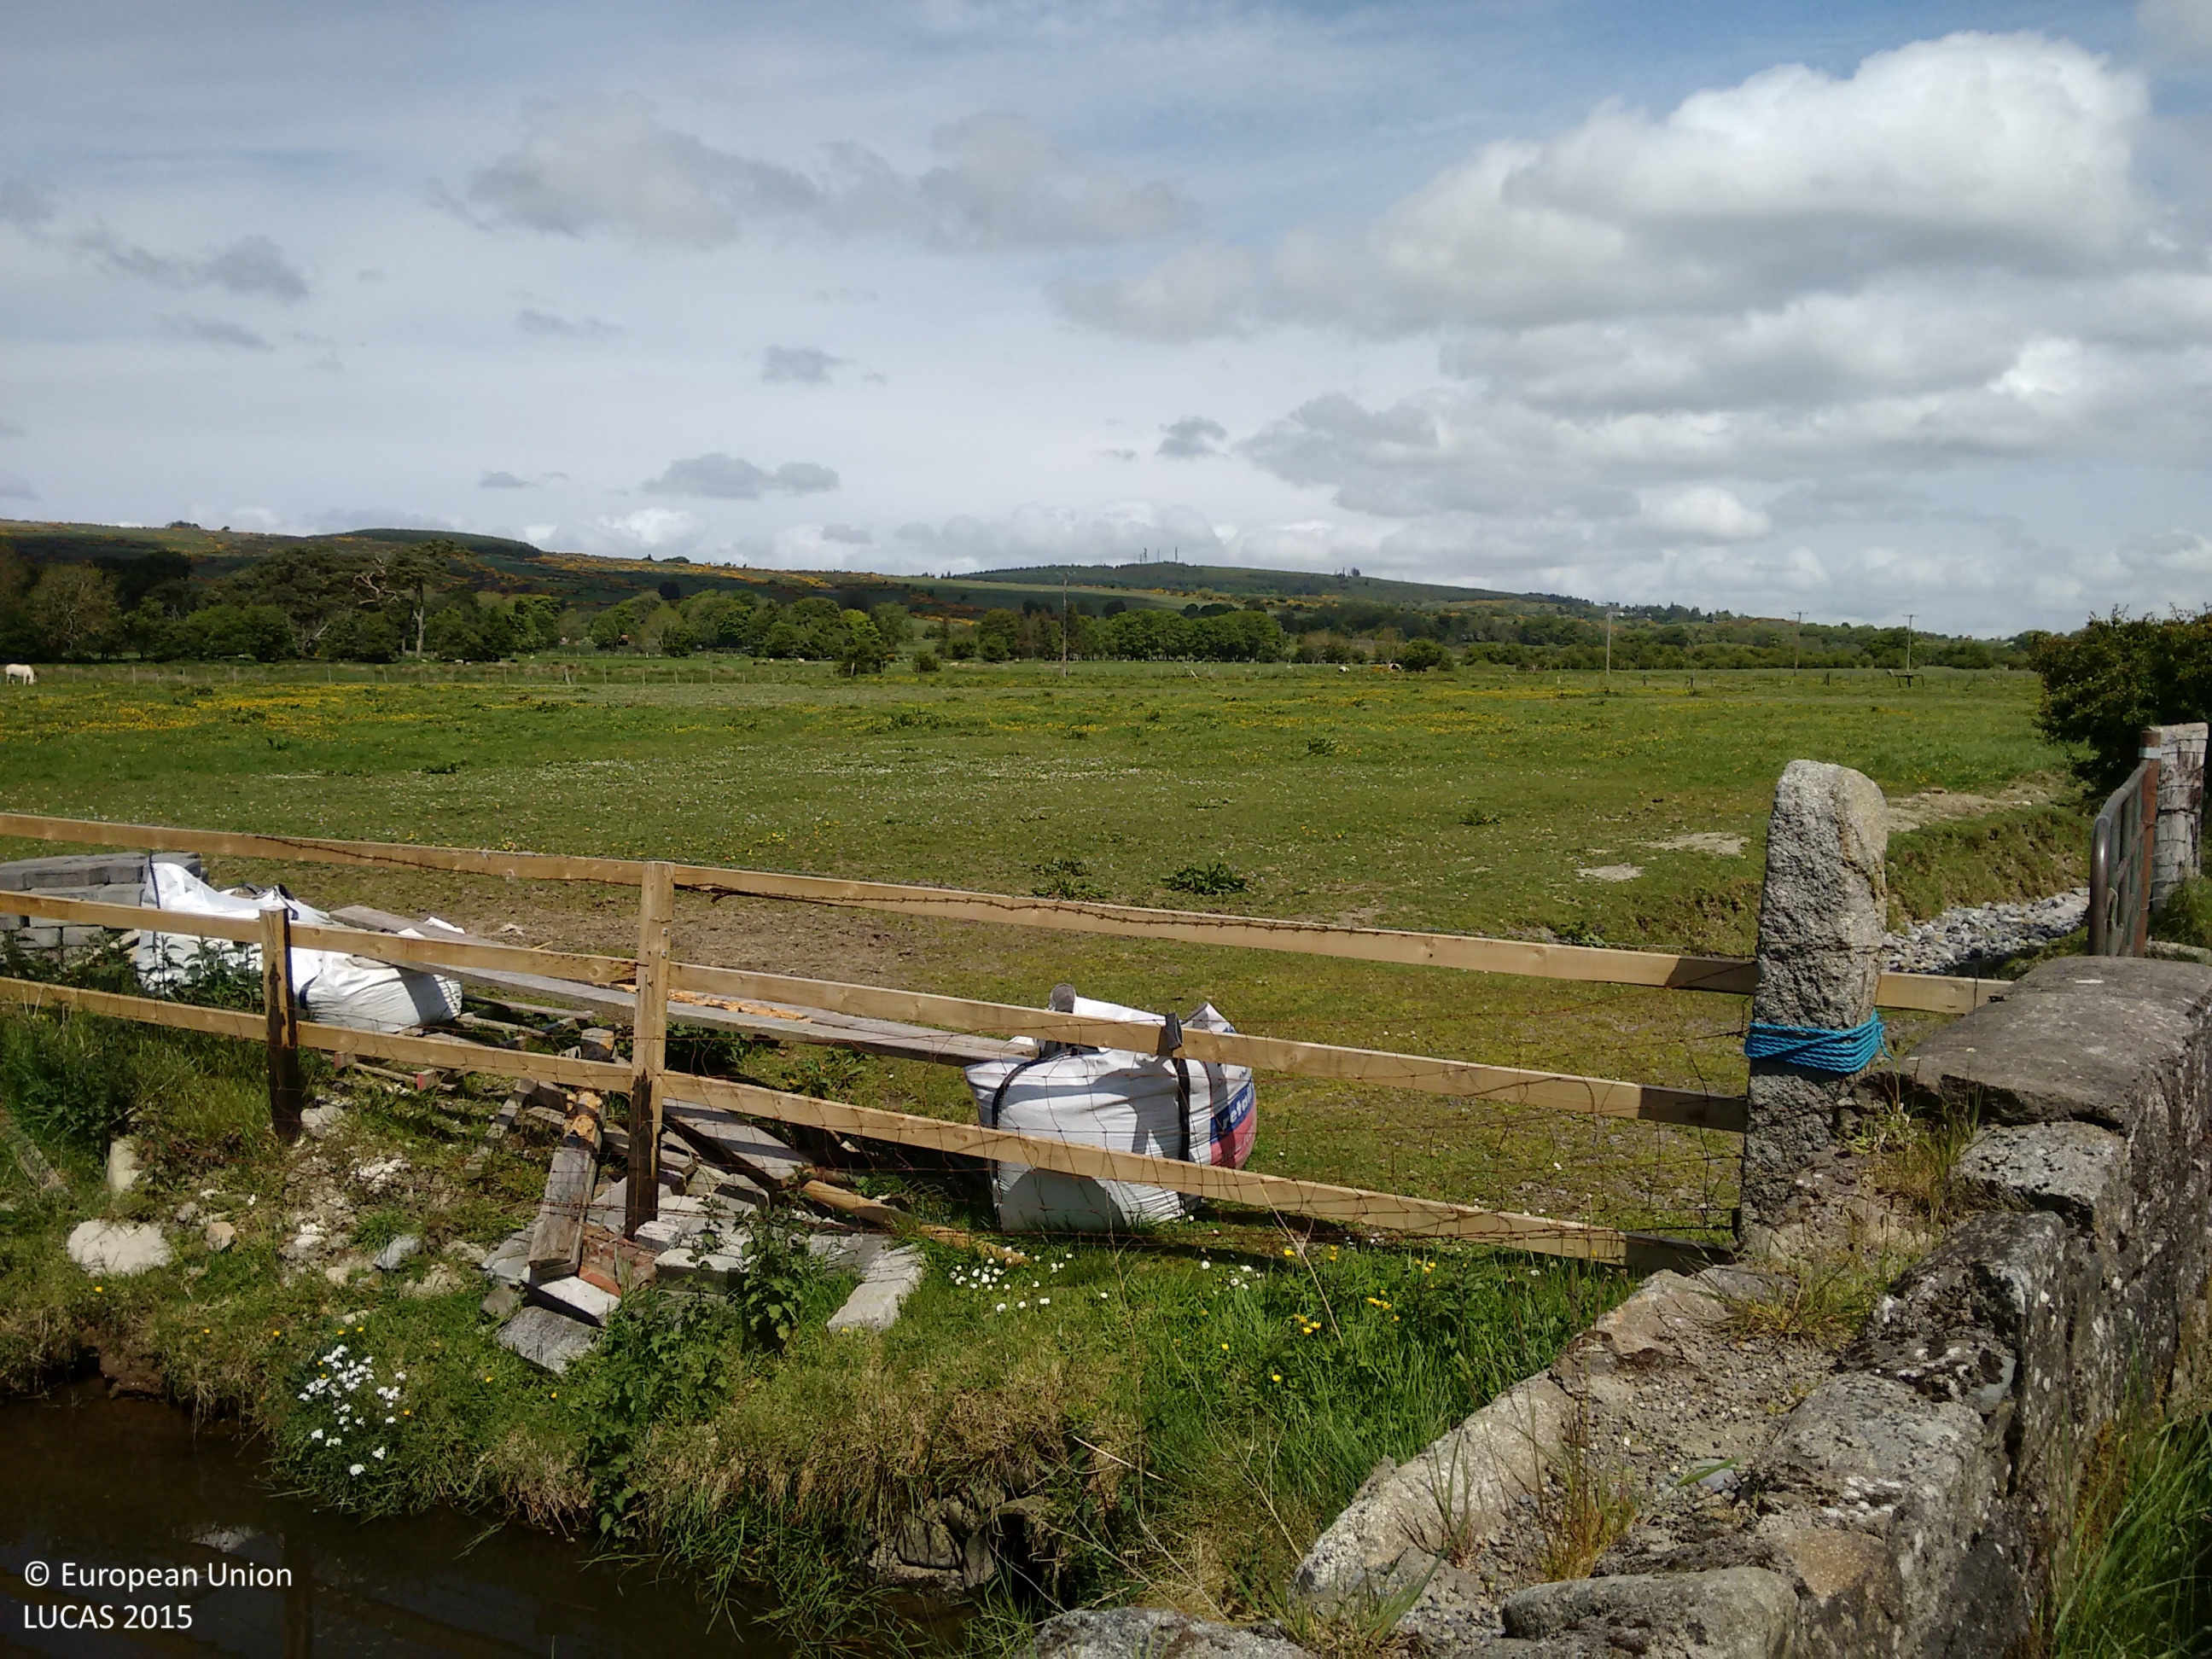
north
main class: Grassland
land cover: Grassland without tree/shrub cover
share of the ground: > 75 %
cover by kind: herbaceous plants 100 %
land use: Agriculture (excluding fallow land and kitchen gardens)
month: June
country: IE
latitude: 53.2189
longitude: -6.4654
